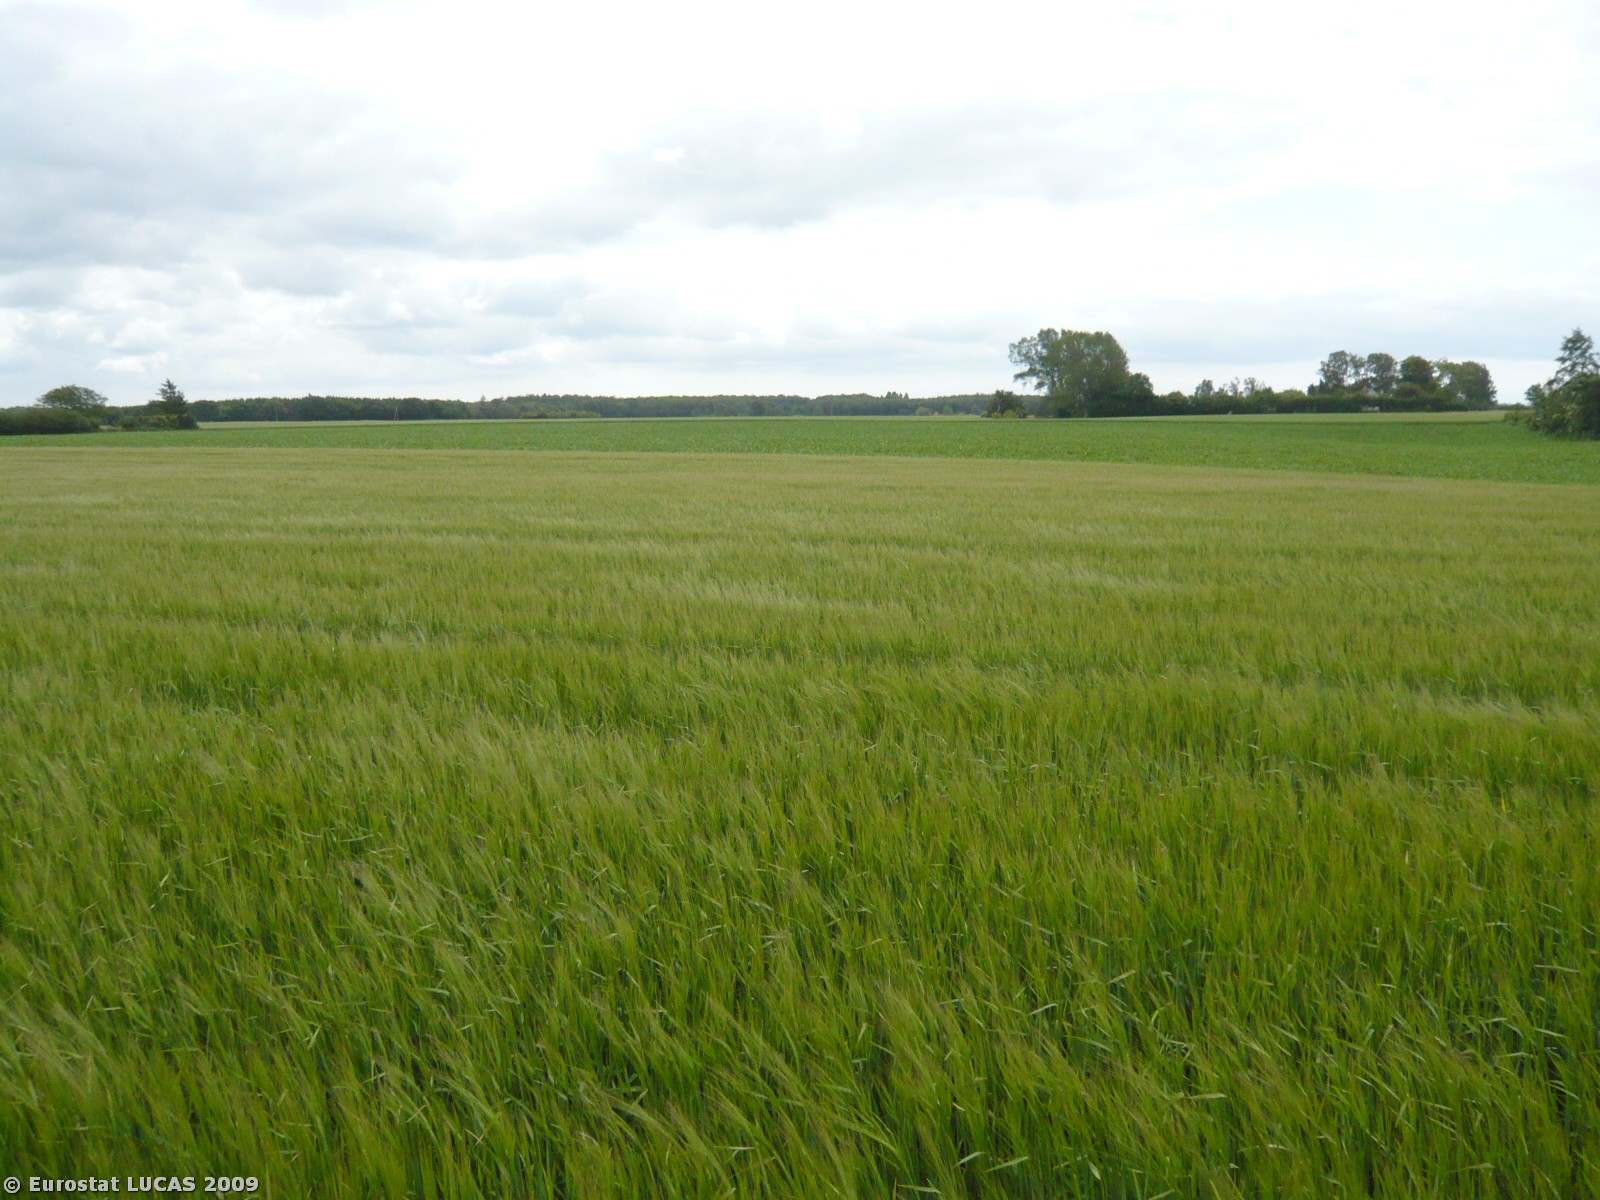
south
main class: Cropland
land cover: Barley
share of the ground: > 75 %
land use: Agriculture (excluding fallow land and kitchen gardens)
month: June
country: DK
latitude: 54.9415
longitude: 11.2323
